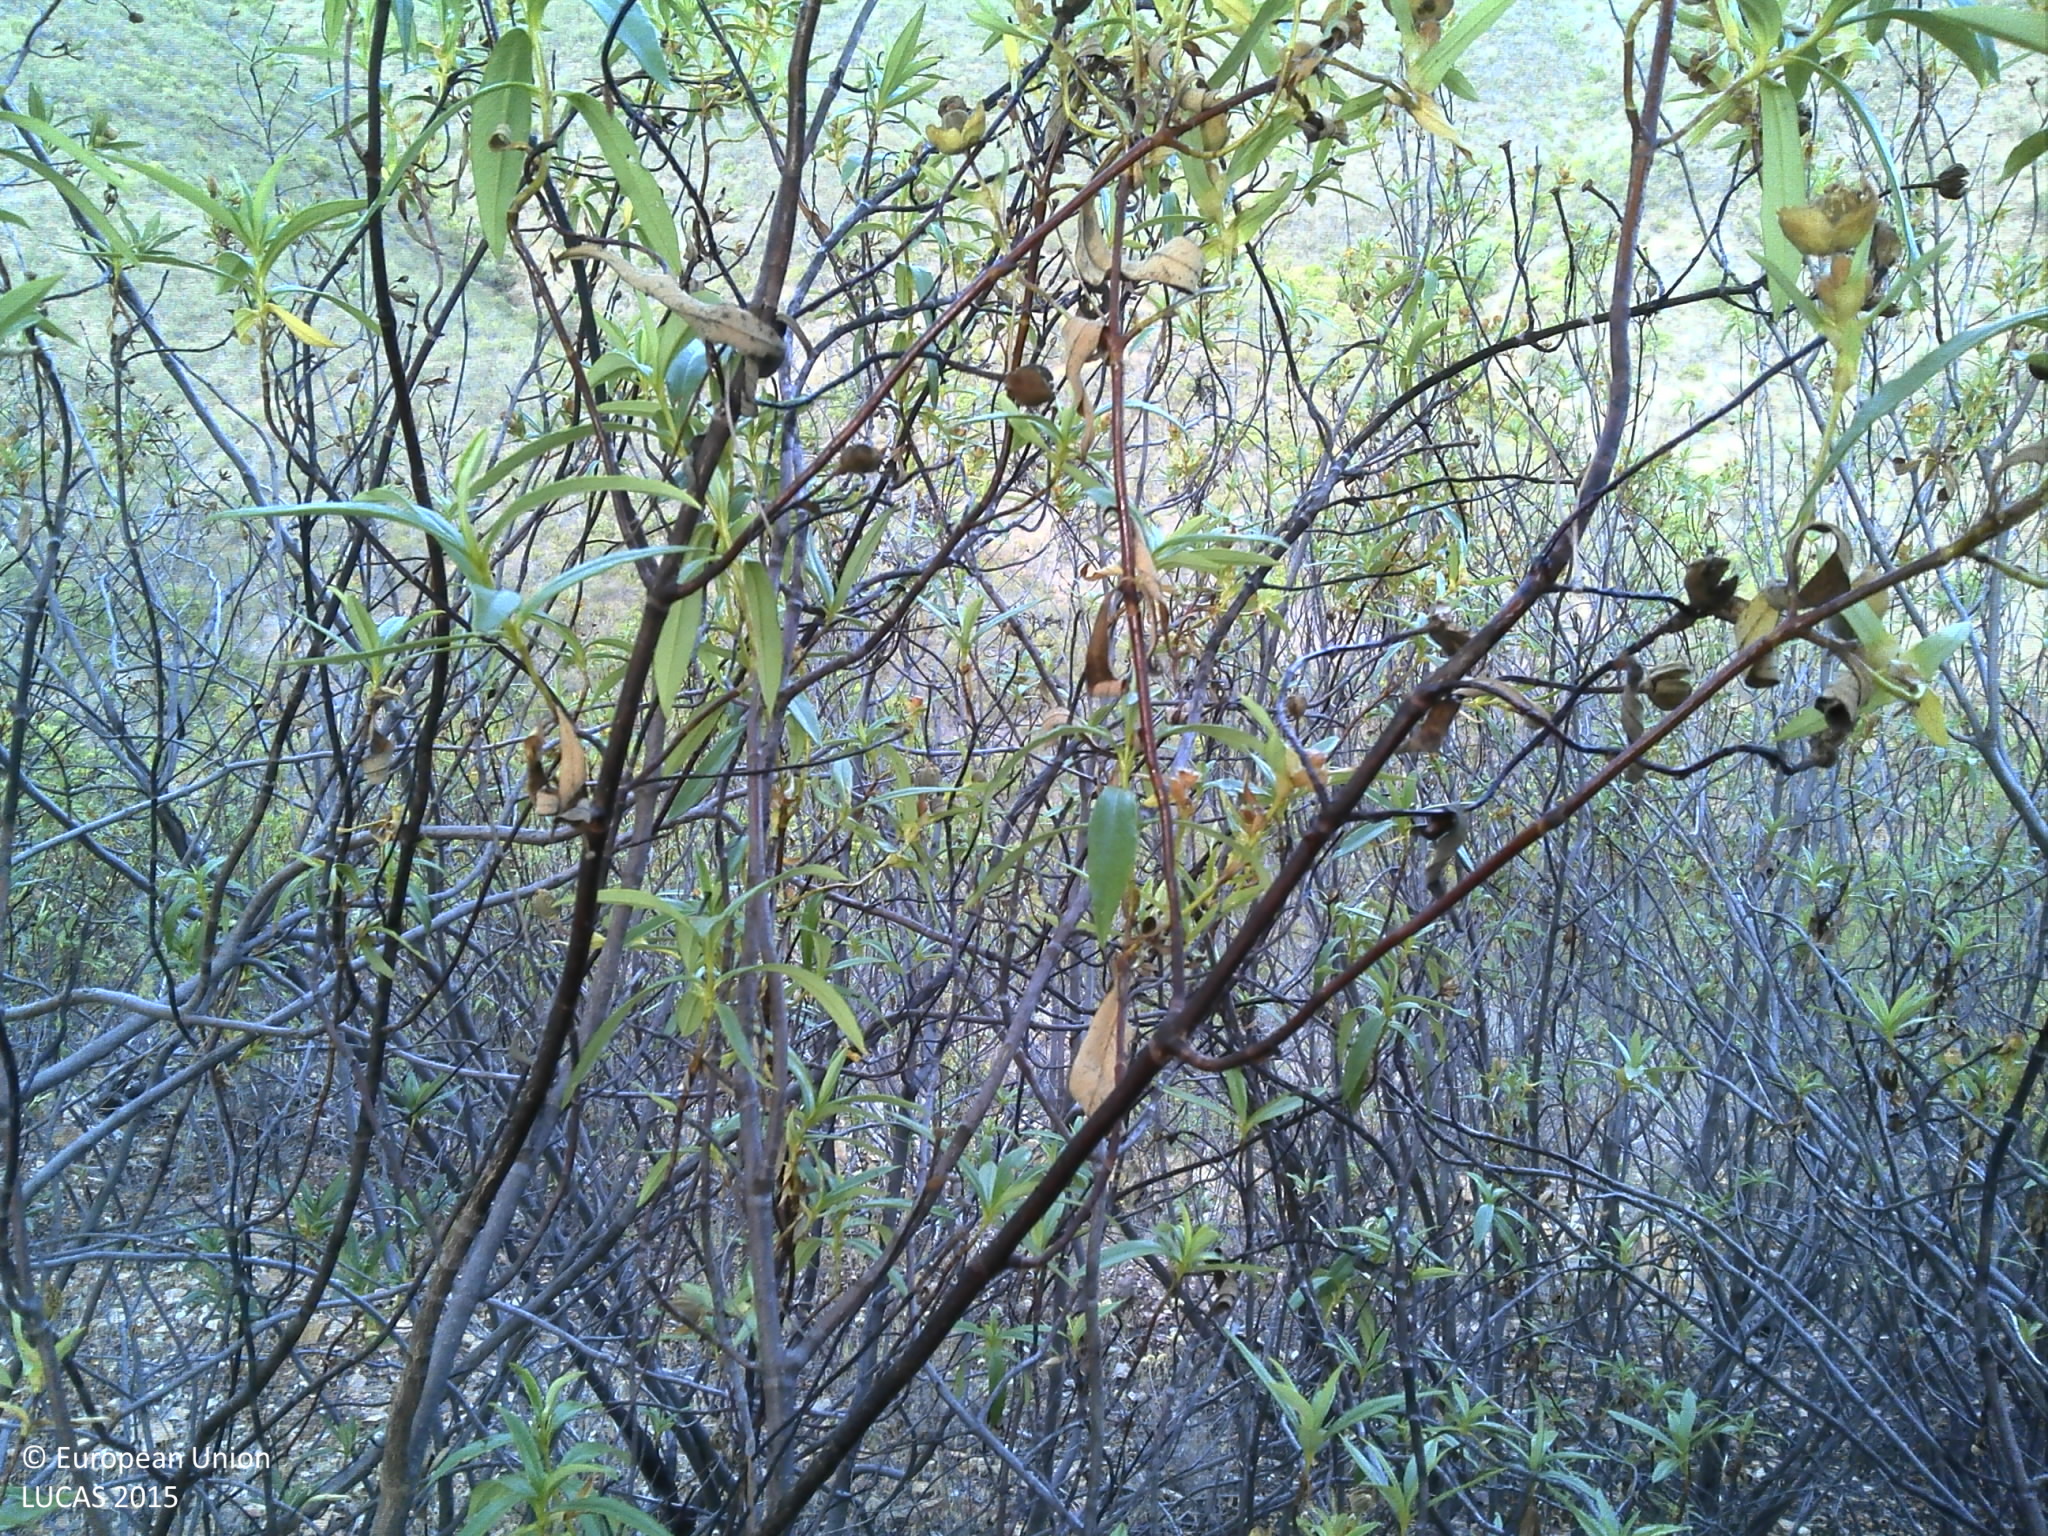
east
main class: Woodland
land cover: Pine dominated coniferous woodland
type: coniferous forest of the mediterranean region
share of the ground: 10 - 25 %
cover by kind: shrubs 90 %, coniferous forest trees 10 %
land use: Forestry
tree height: > 5 m
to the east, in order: Pine dominated coniferous woodland; Shrubland without tree cover; Rivers and streams; Shrubland without tree cover; Rivers and streams; Shrubland without tree cover
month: June
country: PT
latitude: 37.3454
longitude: -7.7222
